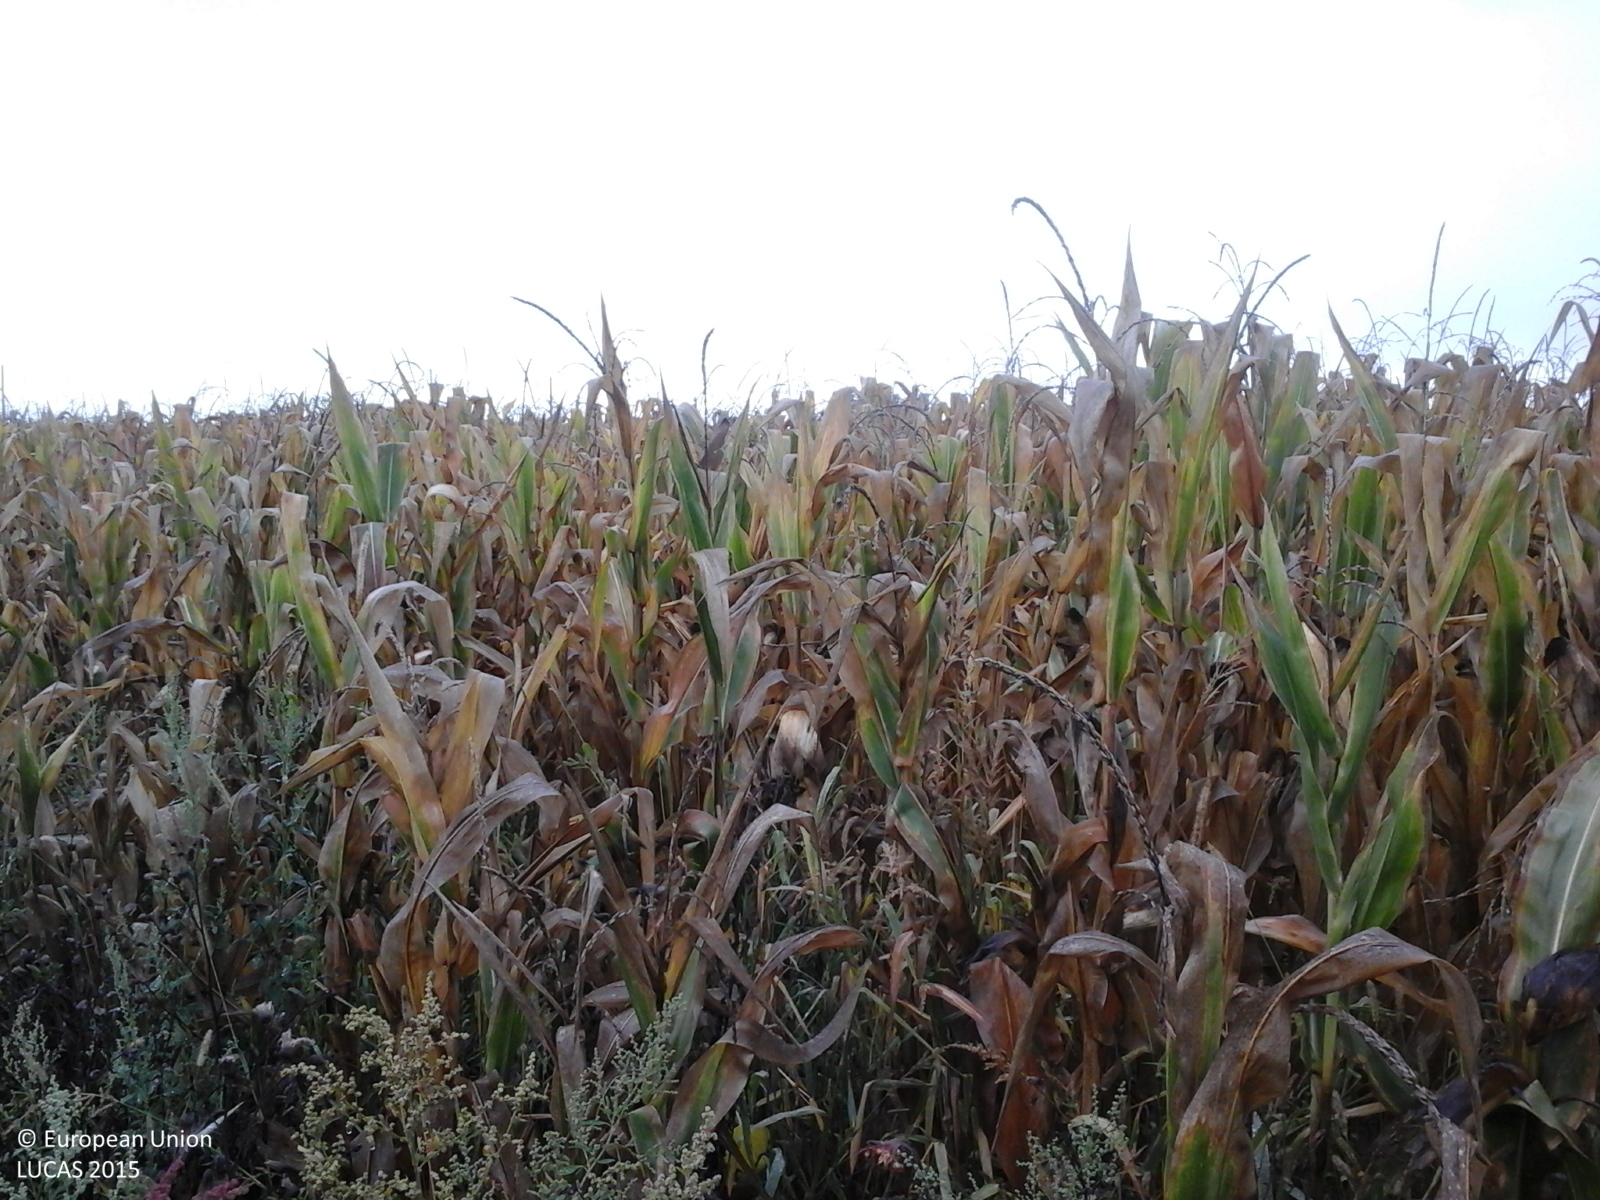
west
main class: Cropland
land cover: Maize
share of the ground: > 75 %
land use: Agriculture (excluding fallow land and kitchen gardens)
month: September
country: RO
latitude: 46.9028
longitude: 21.7395
